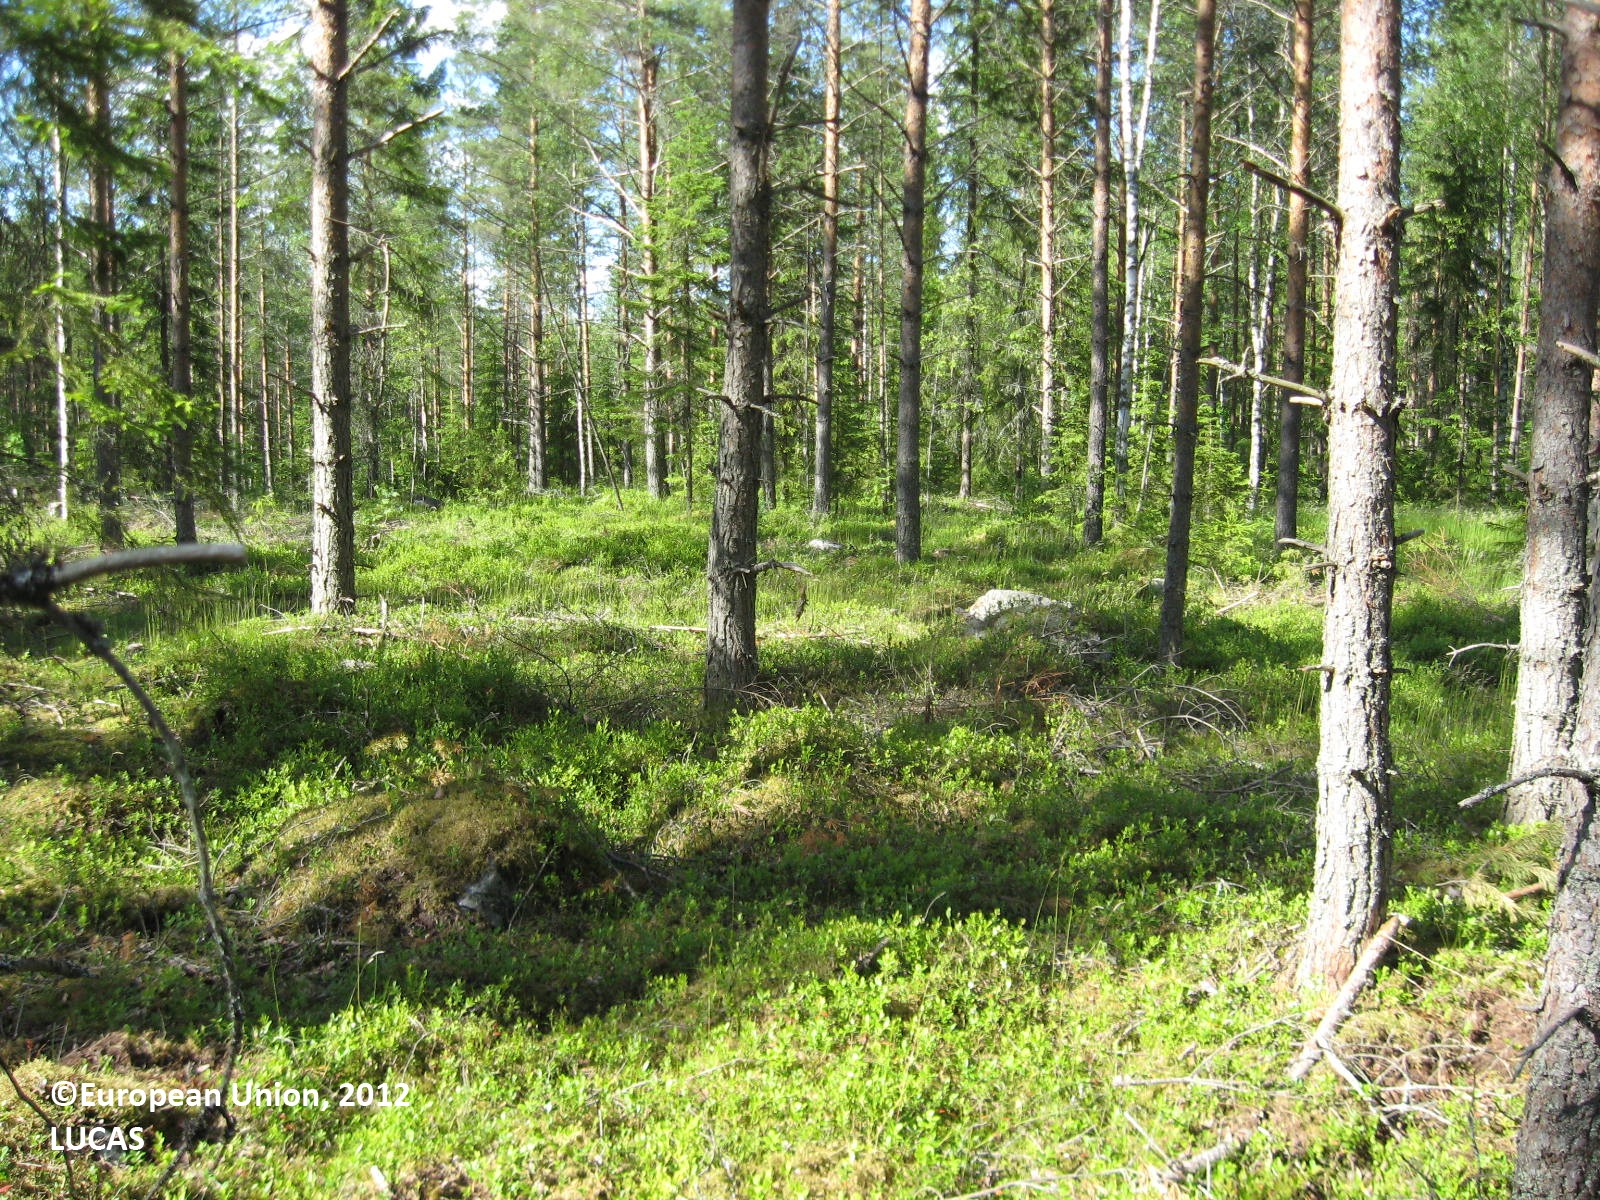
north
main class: Woodland
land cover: Pine dominated coniferous woodland
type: boreal forest
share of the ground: > 75 %
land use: Forestry
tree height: > 5 m
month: June
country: FI
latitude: 62.8183
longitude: 22.7520
